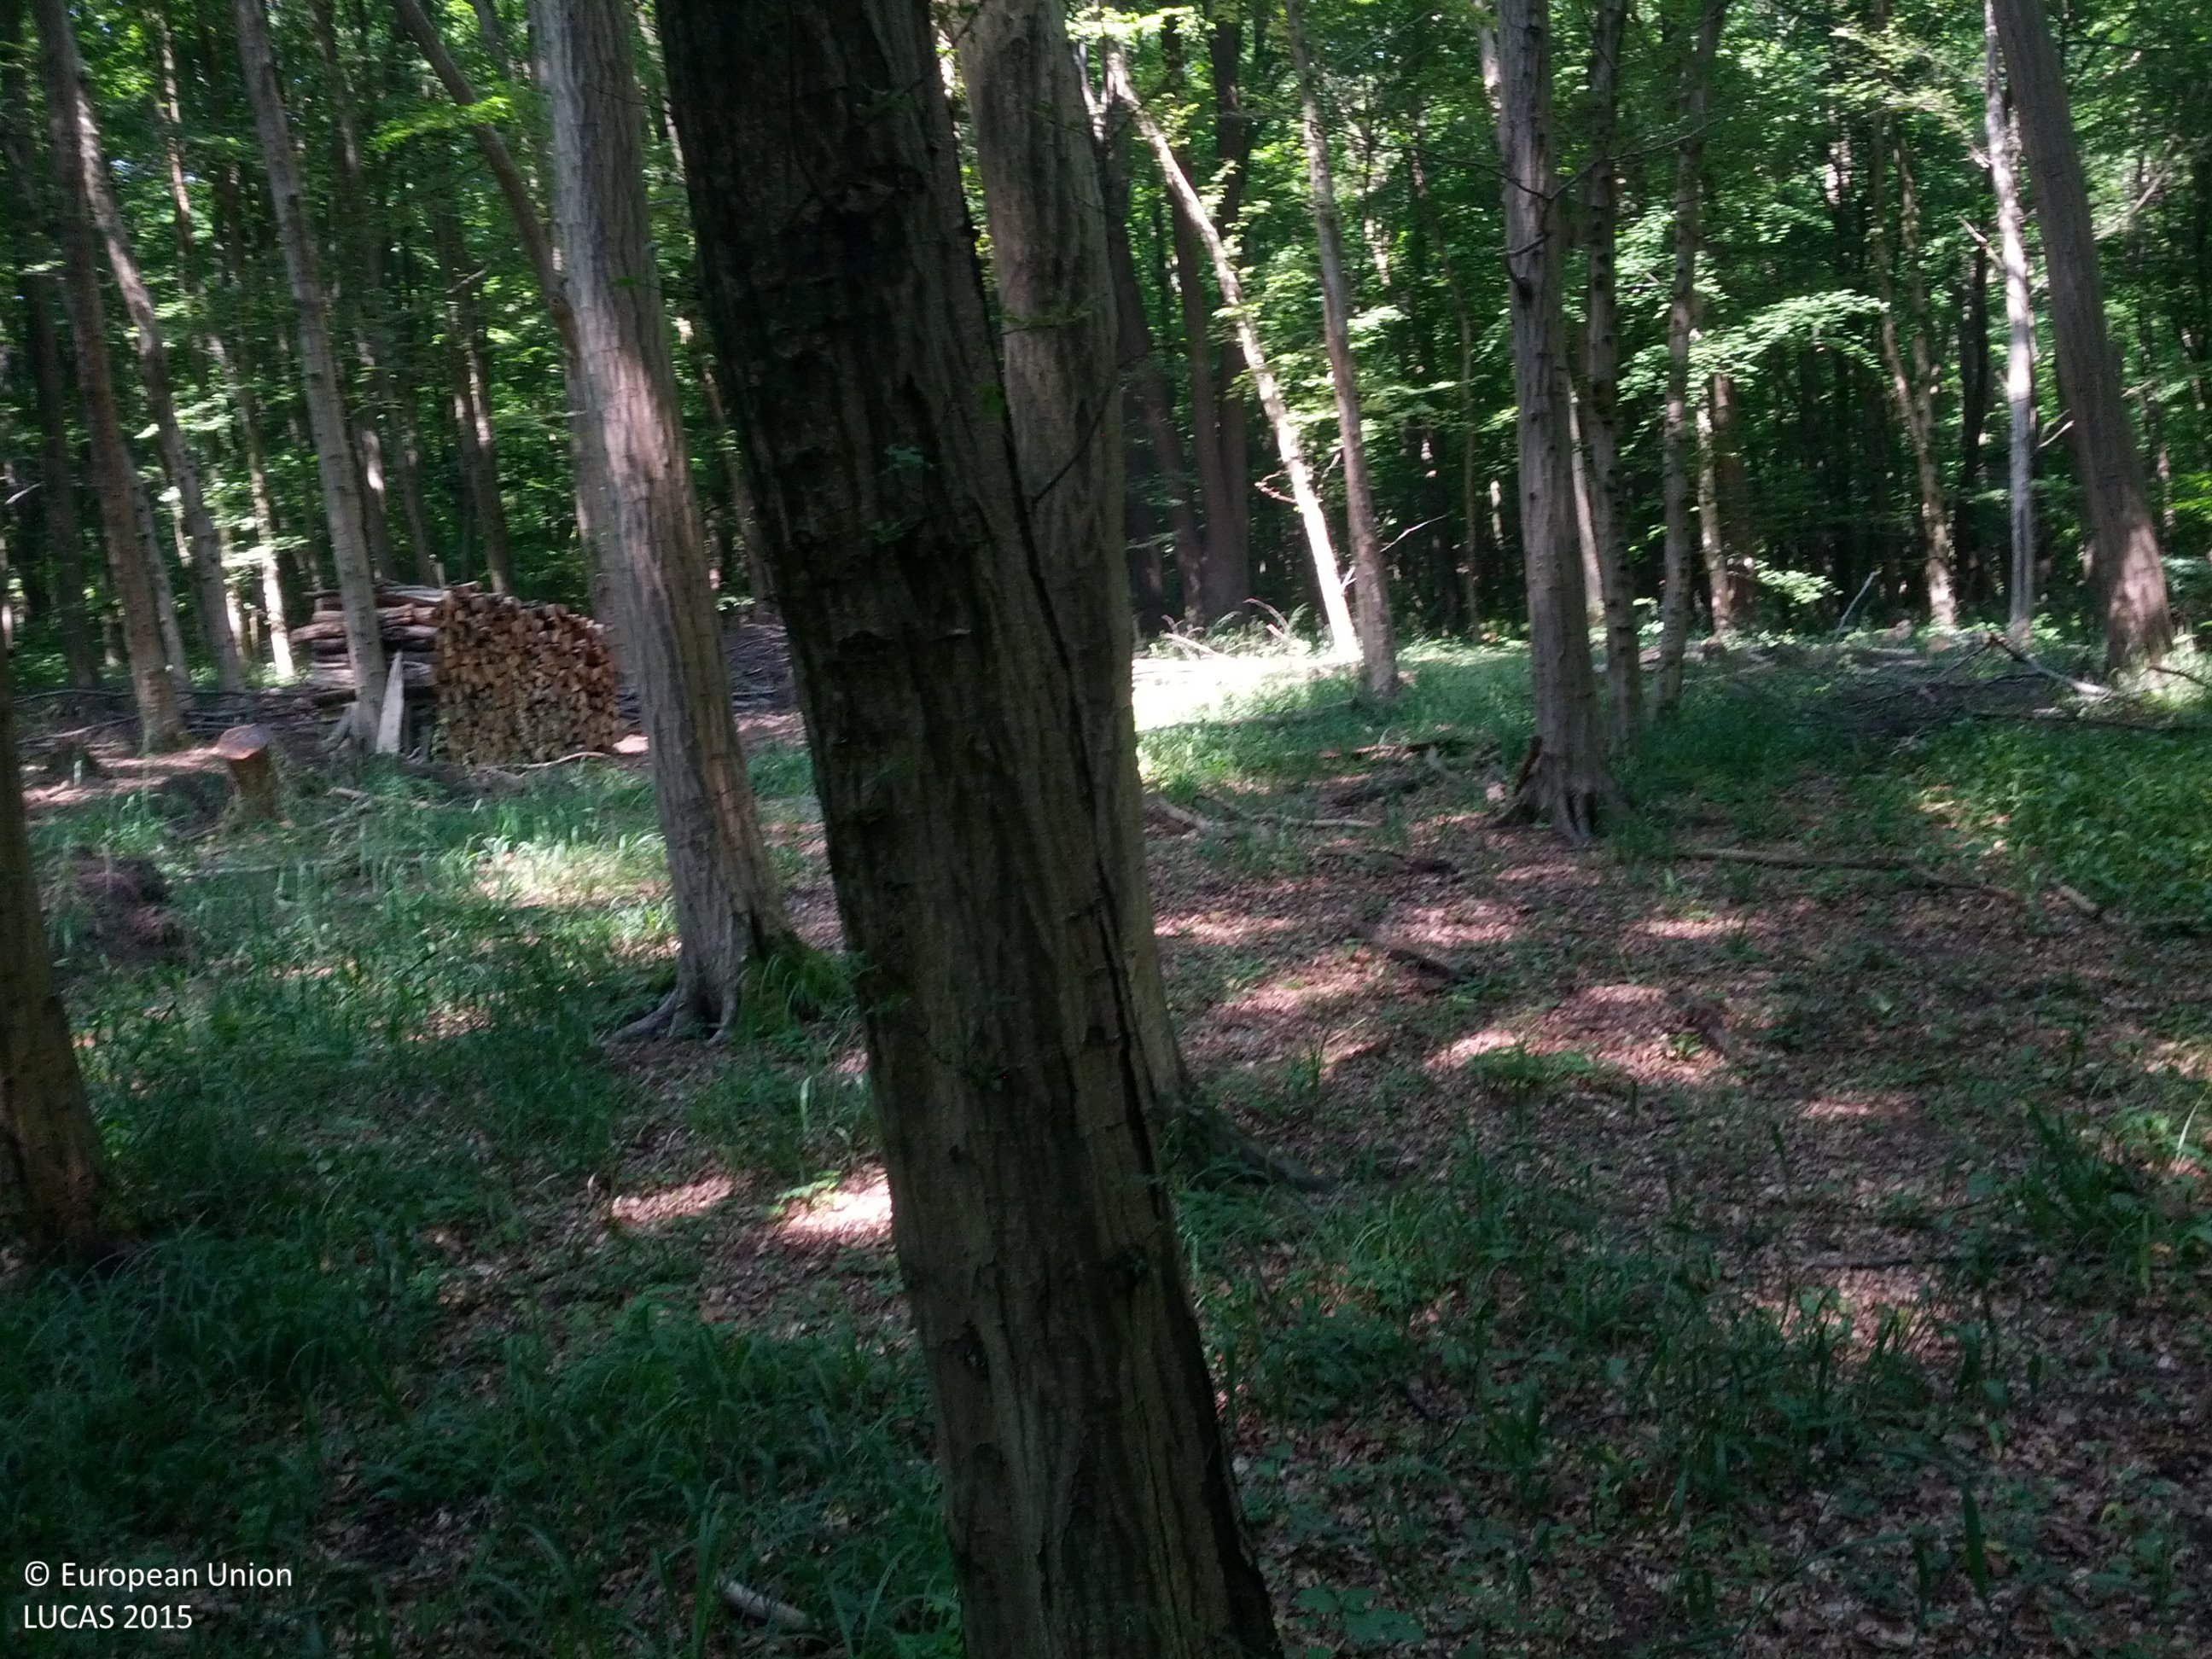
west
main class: Woodland
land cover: Broadleaved woodland
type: beech forest
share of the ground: > 75 %
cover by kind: broadleaved forest trees 80 %, herbaceous plants 20 %
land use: Forestry
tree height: > 5 m
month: May
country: AT
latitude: 48.2274
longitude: 16.2373
